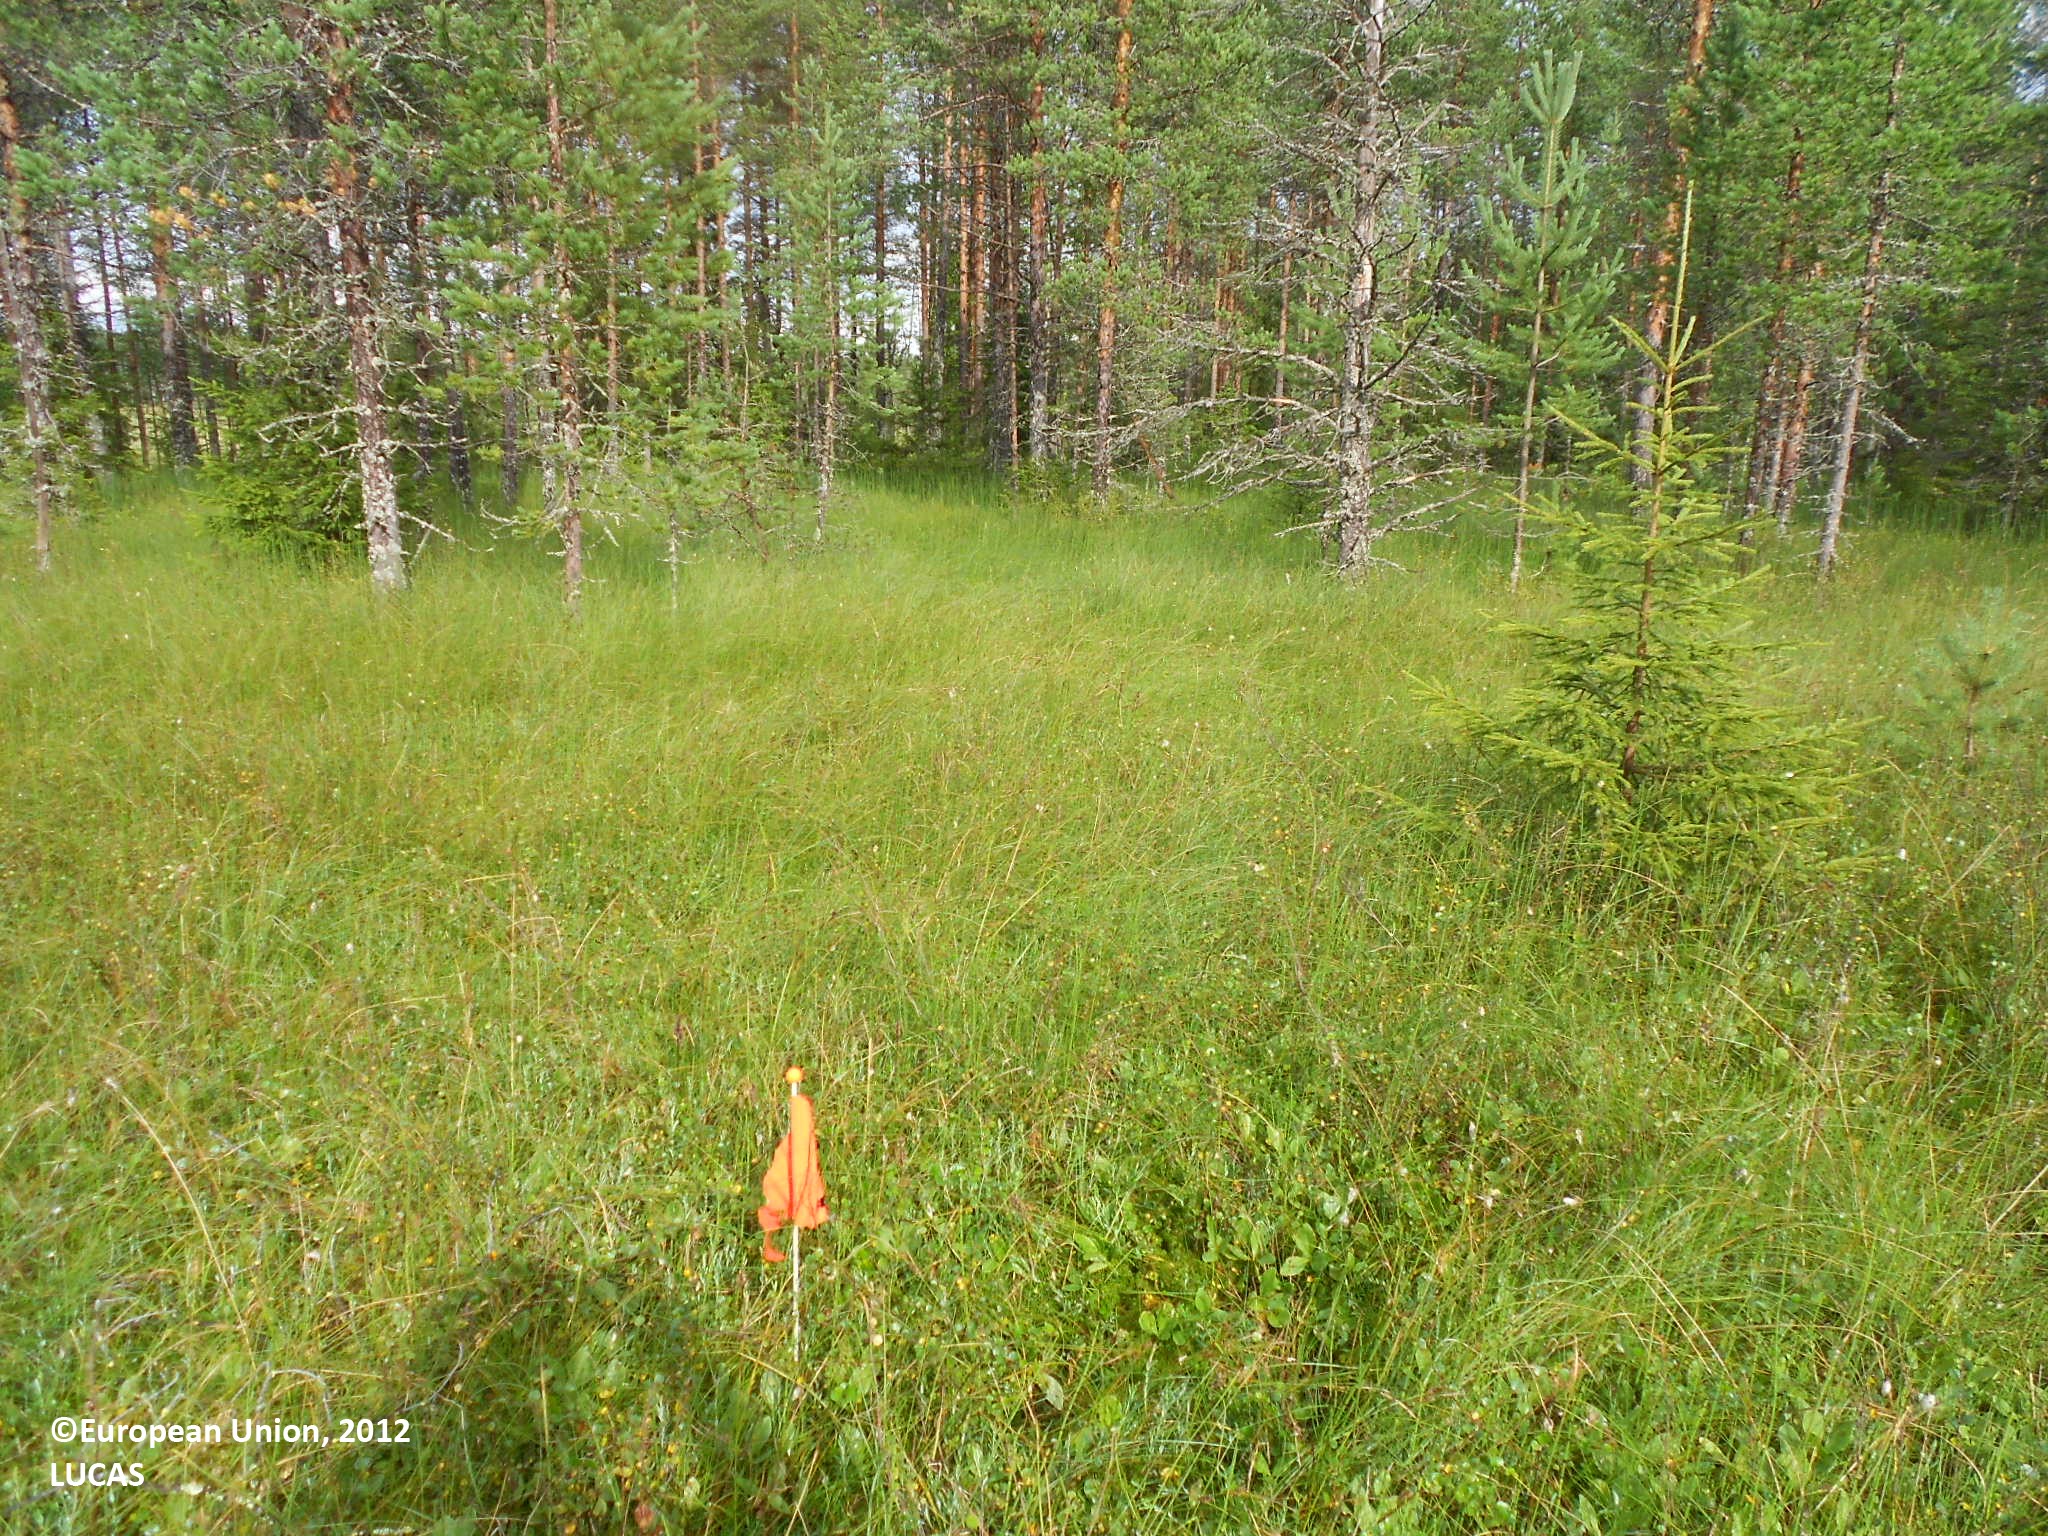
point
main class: Woodland
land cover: Pine dominated coniferous woodland
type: boreal forest
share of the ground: 10 - 25 %
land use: Semi-natural and natural areas not in use
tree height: > 5 m
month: August
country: FI
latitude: 63.5746
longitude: 28.4958
